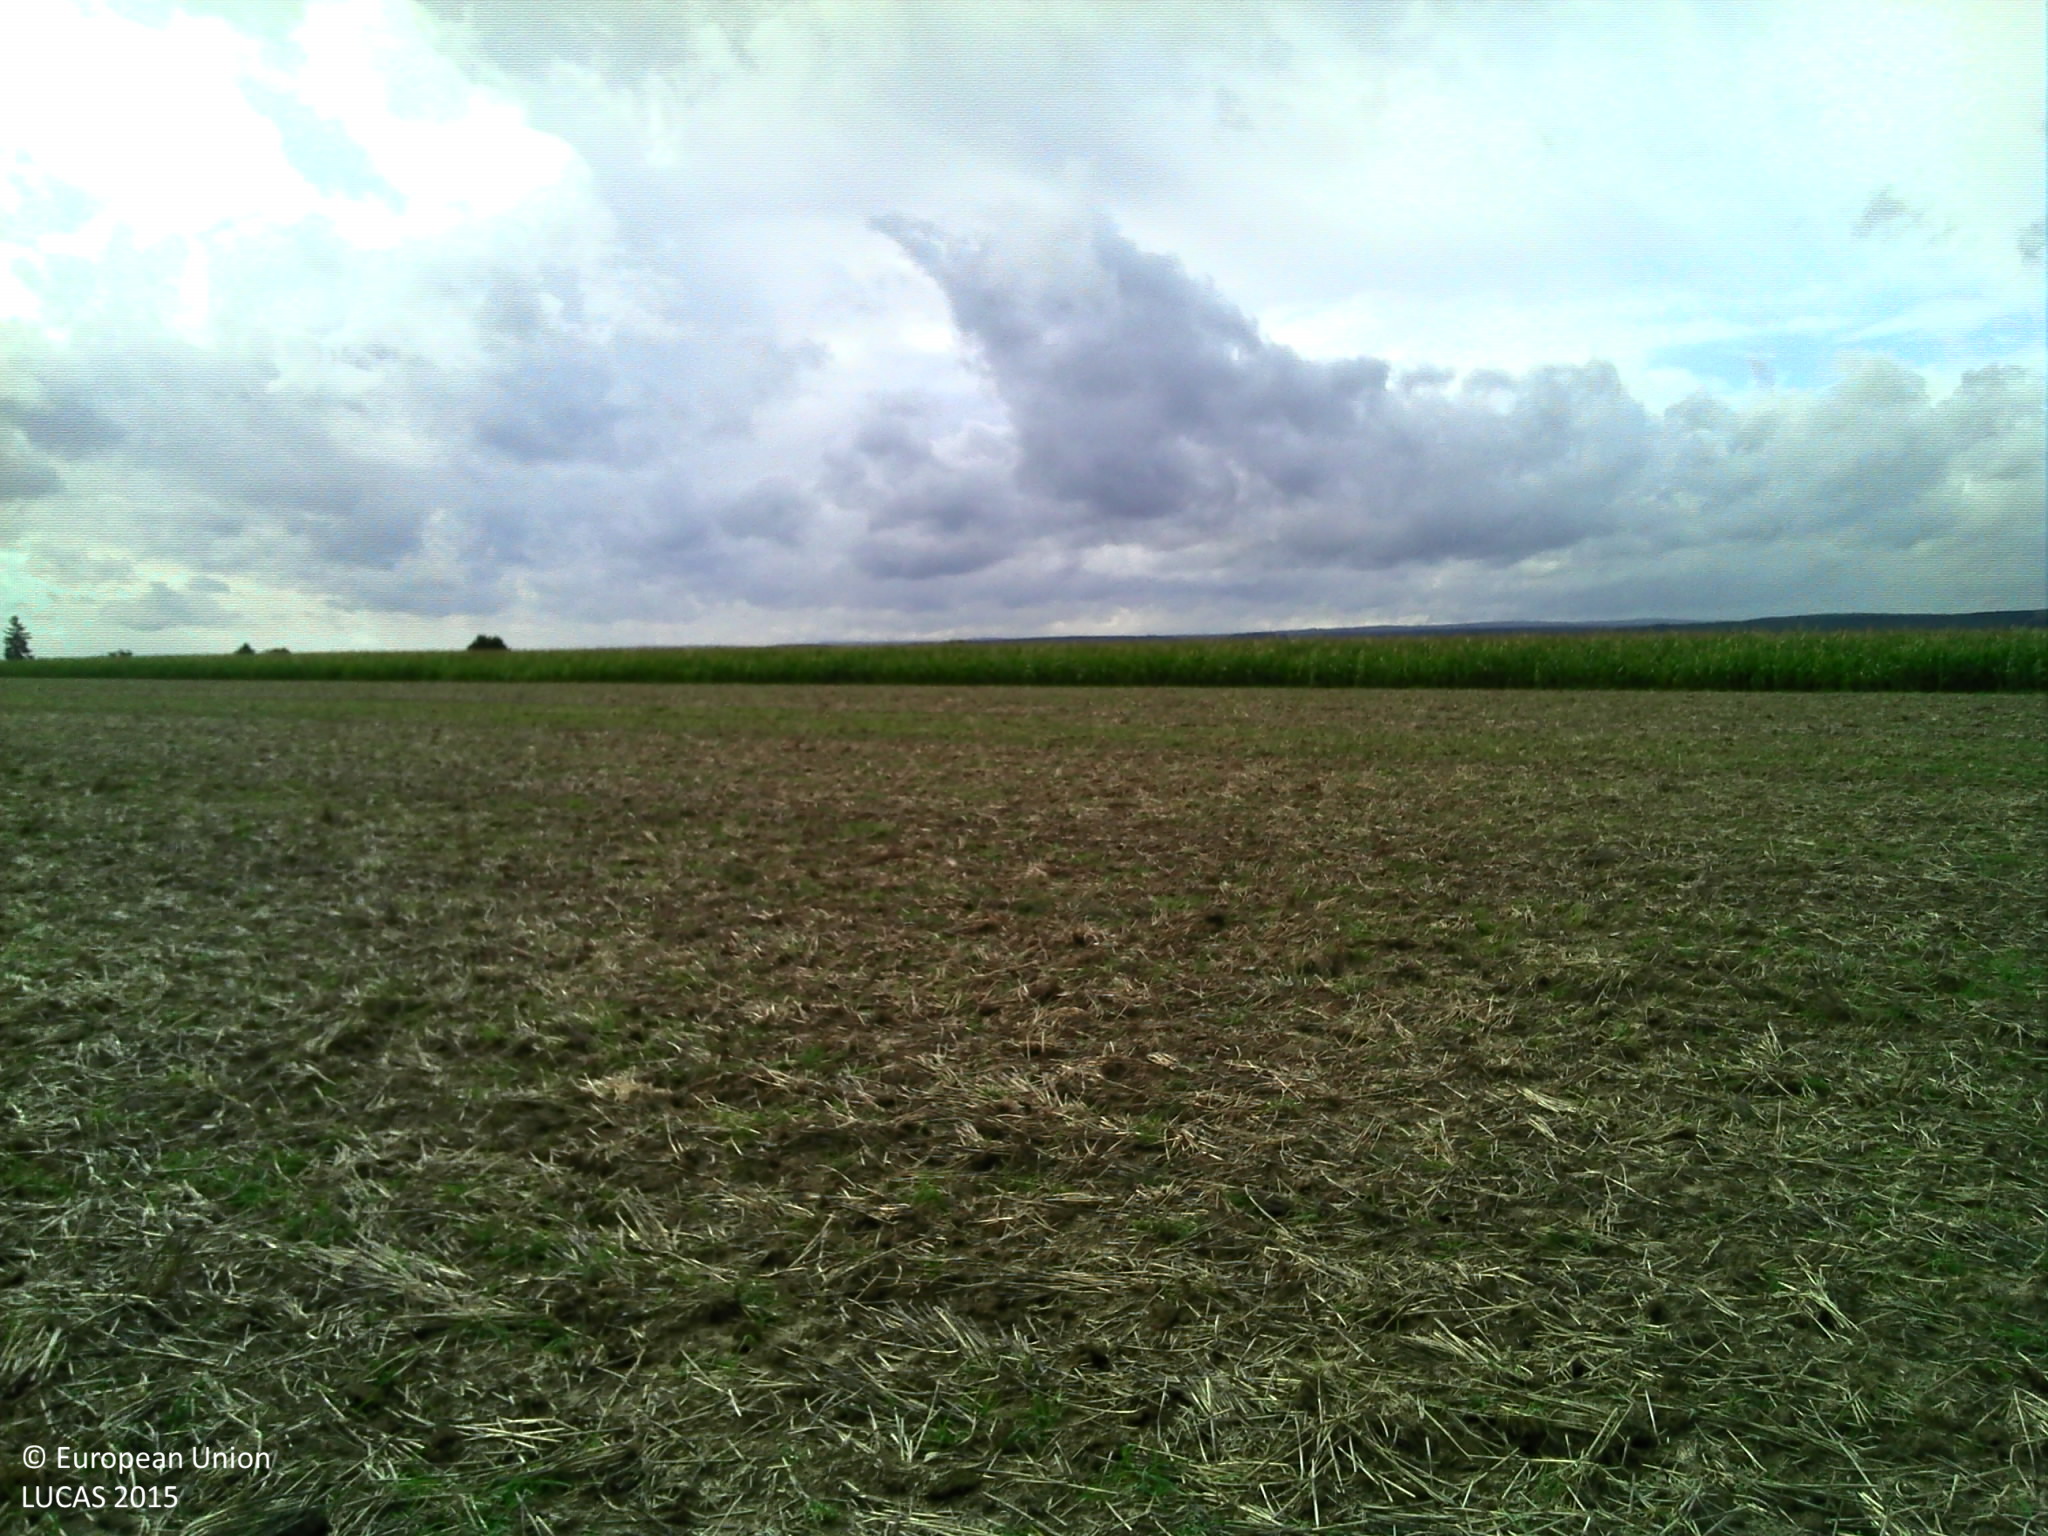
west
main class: Grassland
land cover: Spontaneously vegetated surfaces
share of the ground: 25 - 50 %
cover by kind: unconsolidated bare surface 60 %, herbaceous plants 40 %
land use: Agriculture (excluding fallow land and kitchen gardens)
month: September
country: FR
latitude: 47.1006
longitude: 5.0072
